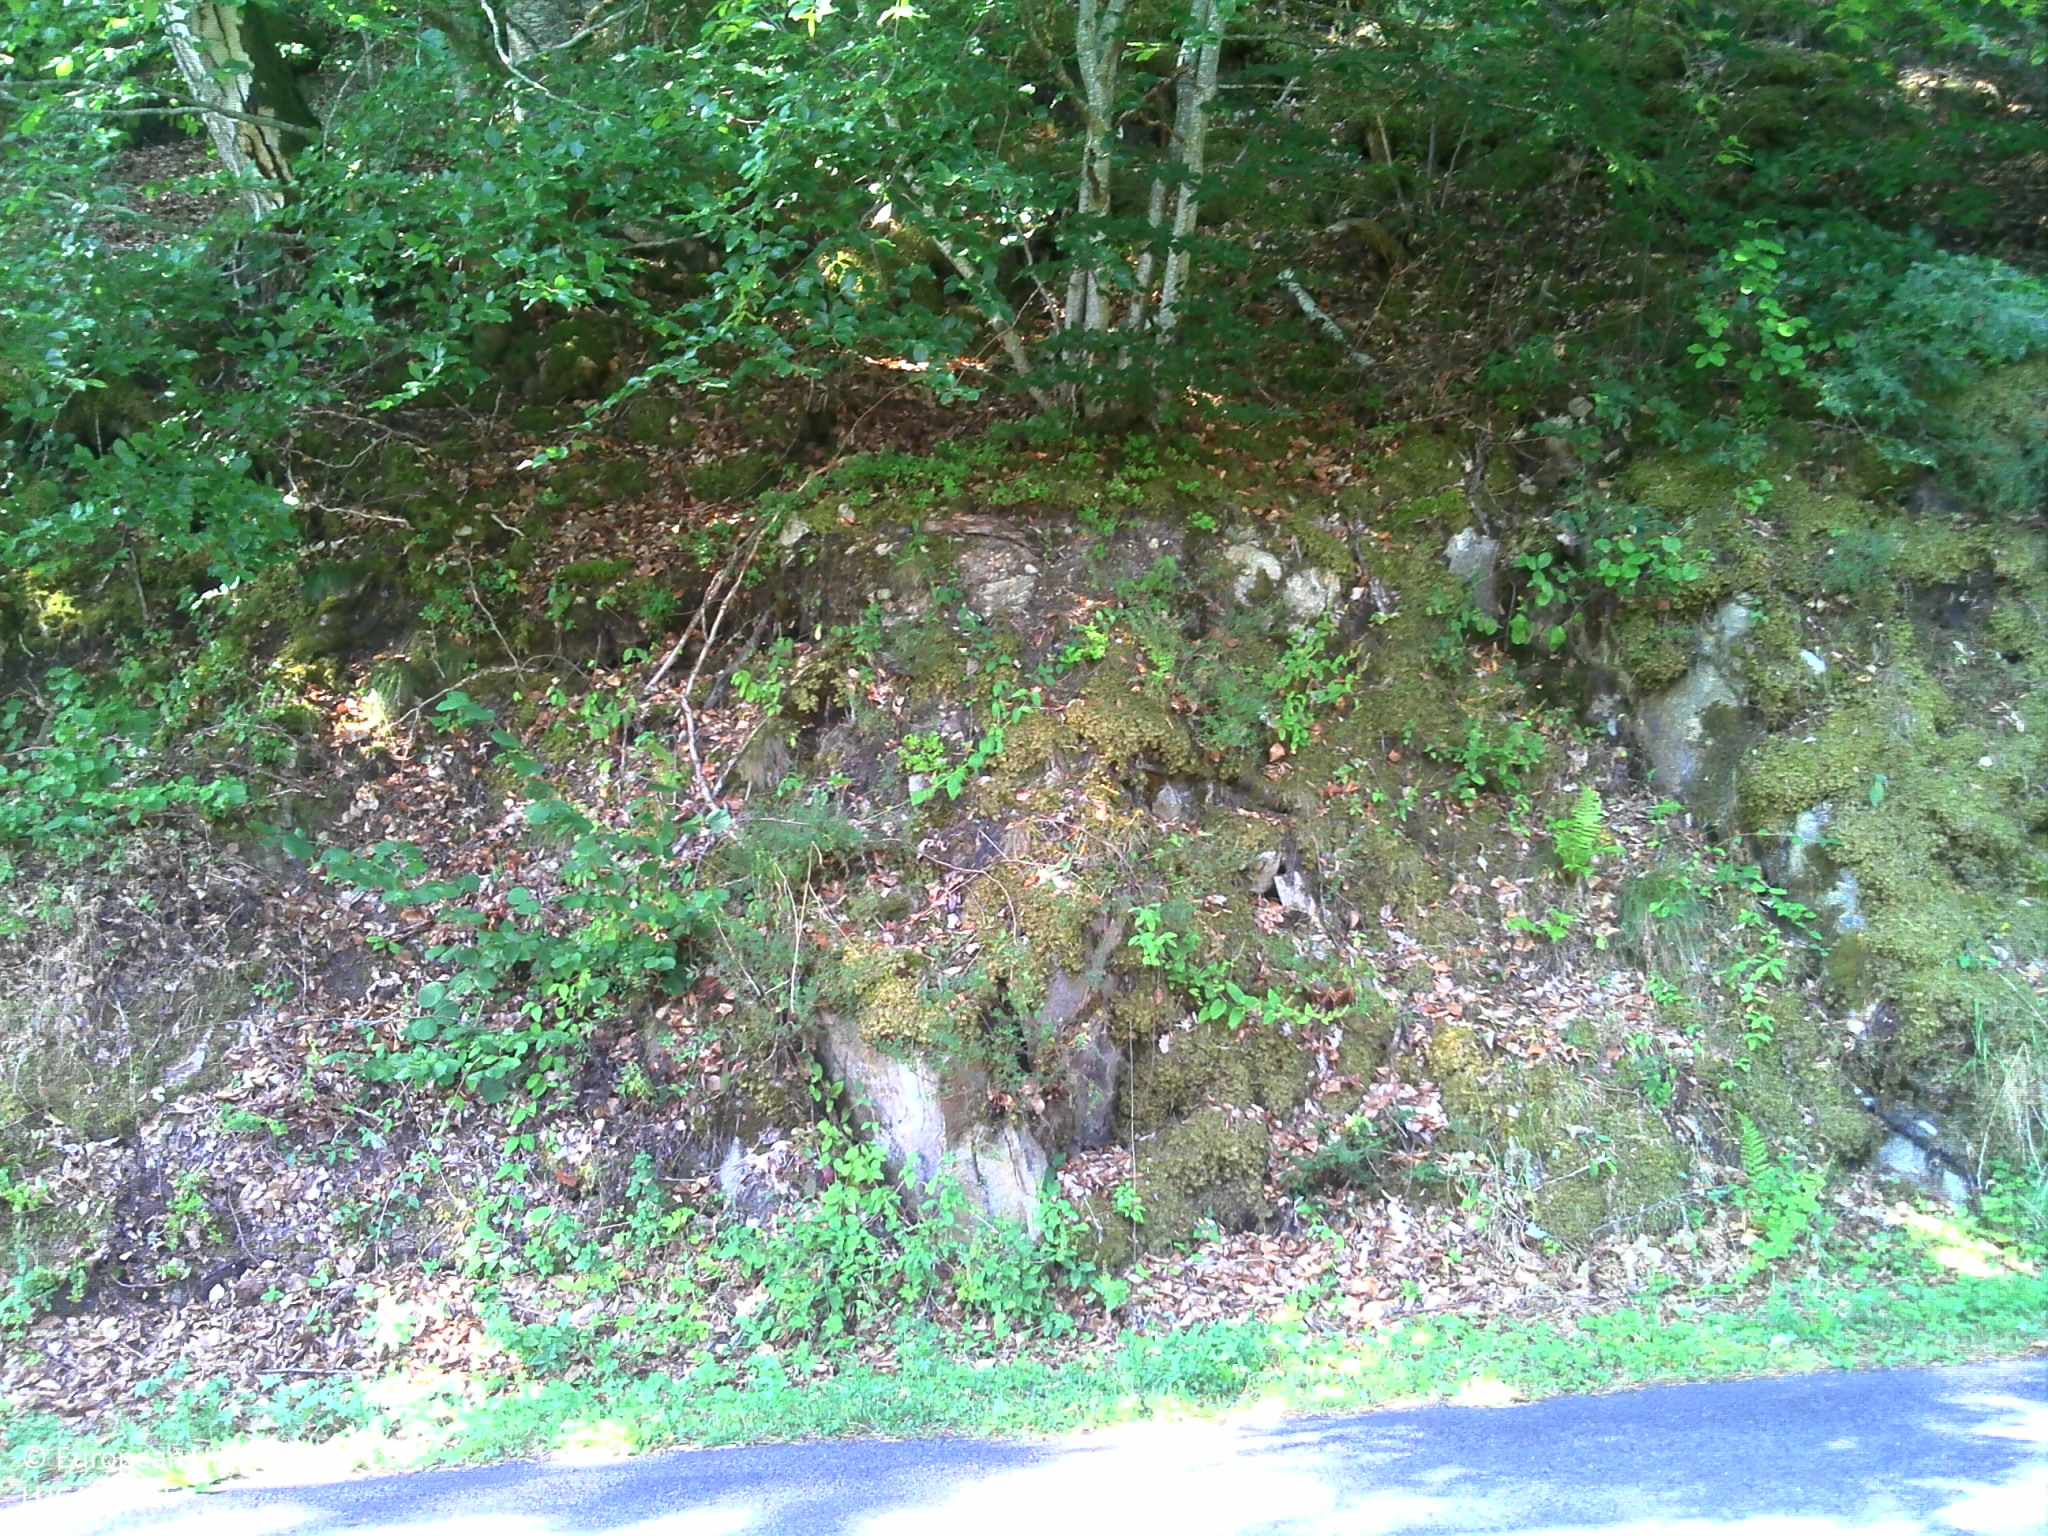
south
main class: Woodland
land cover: Broadleaved woodland
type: acidophilous oak and oak-birch forest
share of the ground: > 75 %
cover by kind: broadleaved forest trees 80 %, coniferous forest trees 10 %, shrubs 10 %
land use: Forestry
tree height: > 5 m
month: August
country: FR
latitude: 45.2168
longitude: 3.8530
